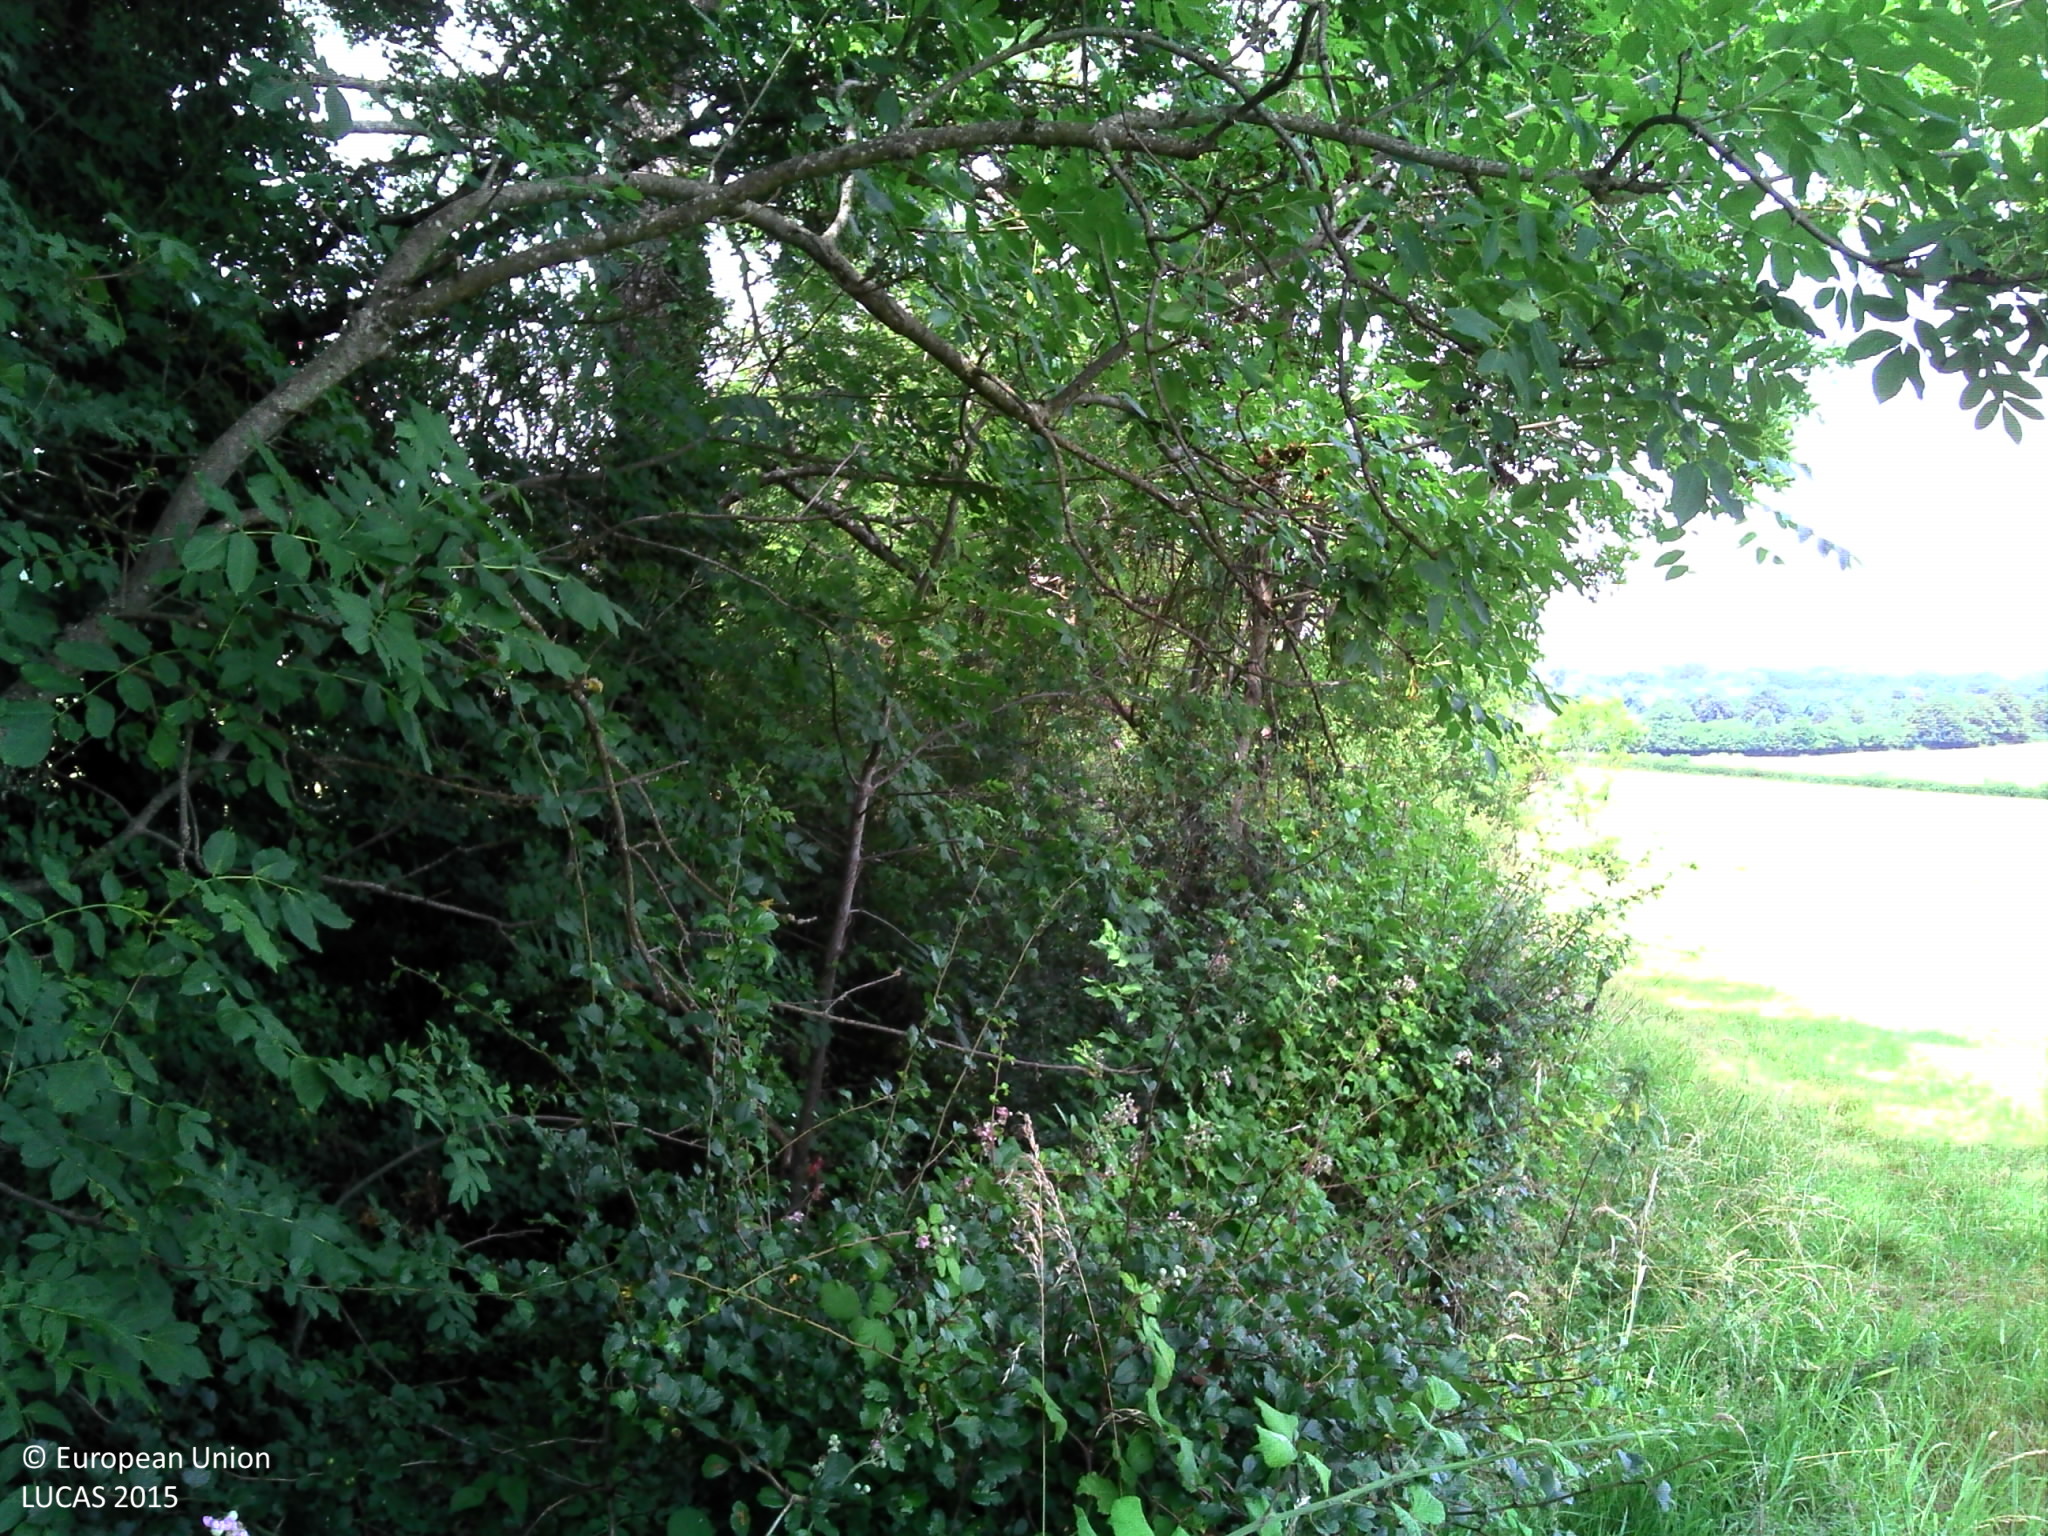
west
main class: Grassland
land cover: Grassland without tree/shrub cover
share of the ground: > 75 %
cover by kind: herbaceous plants 100 %
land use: Agriculture (excluding fallow land and kitchen gardens)
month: July
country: FR
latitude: 47.1124
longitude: 3.5265
